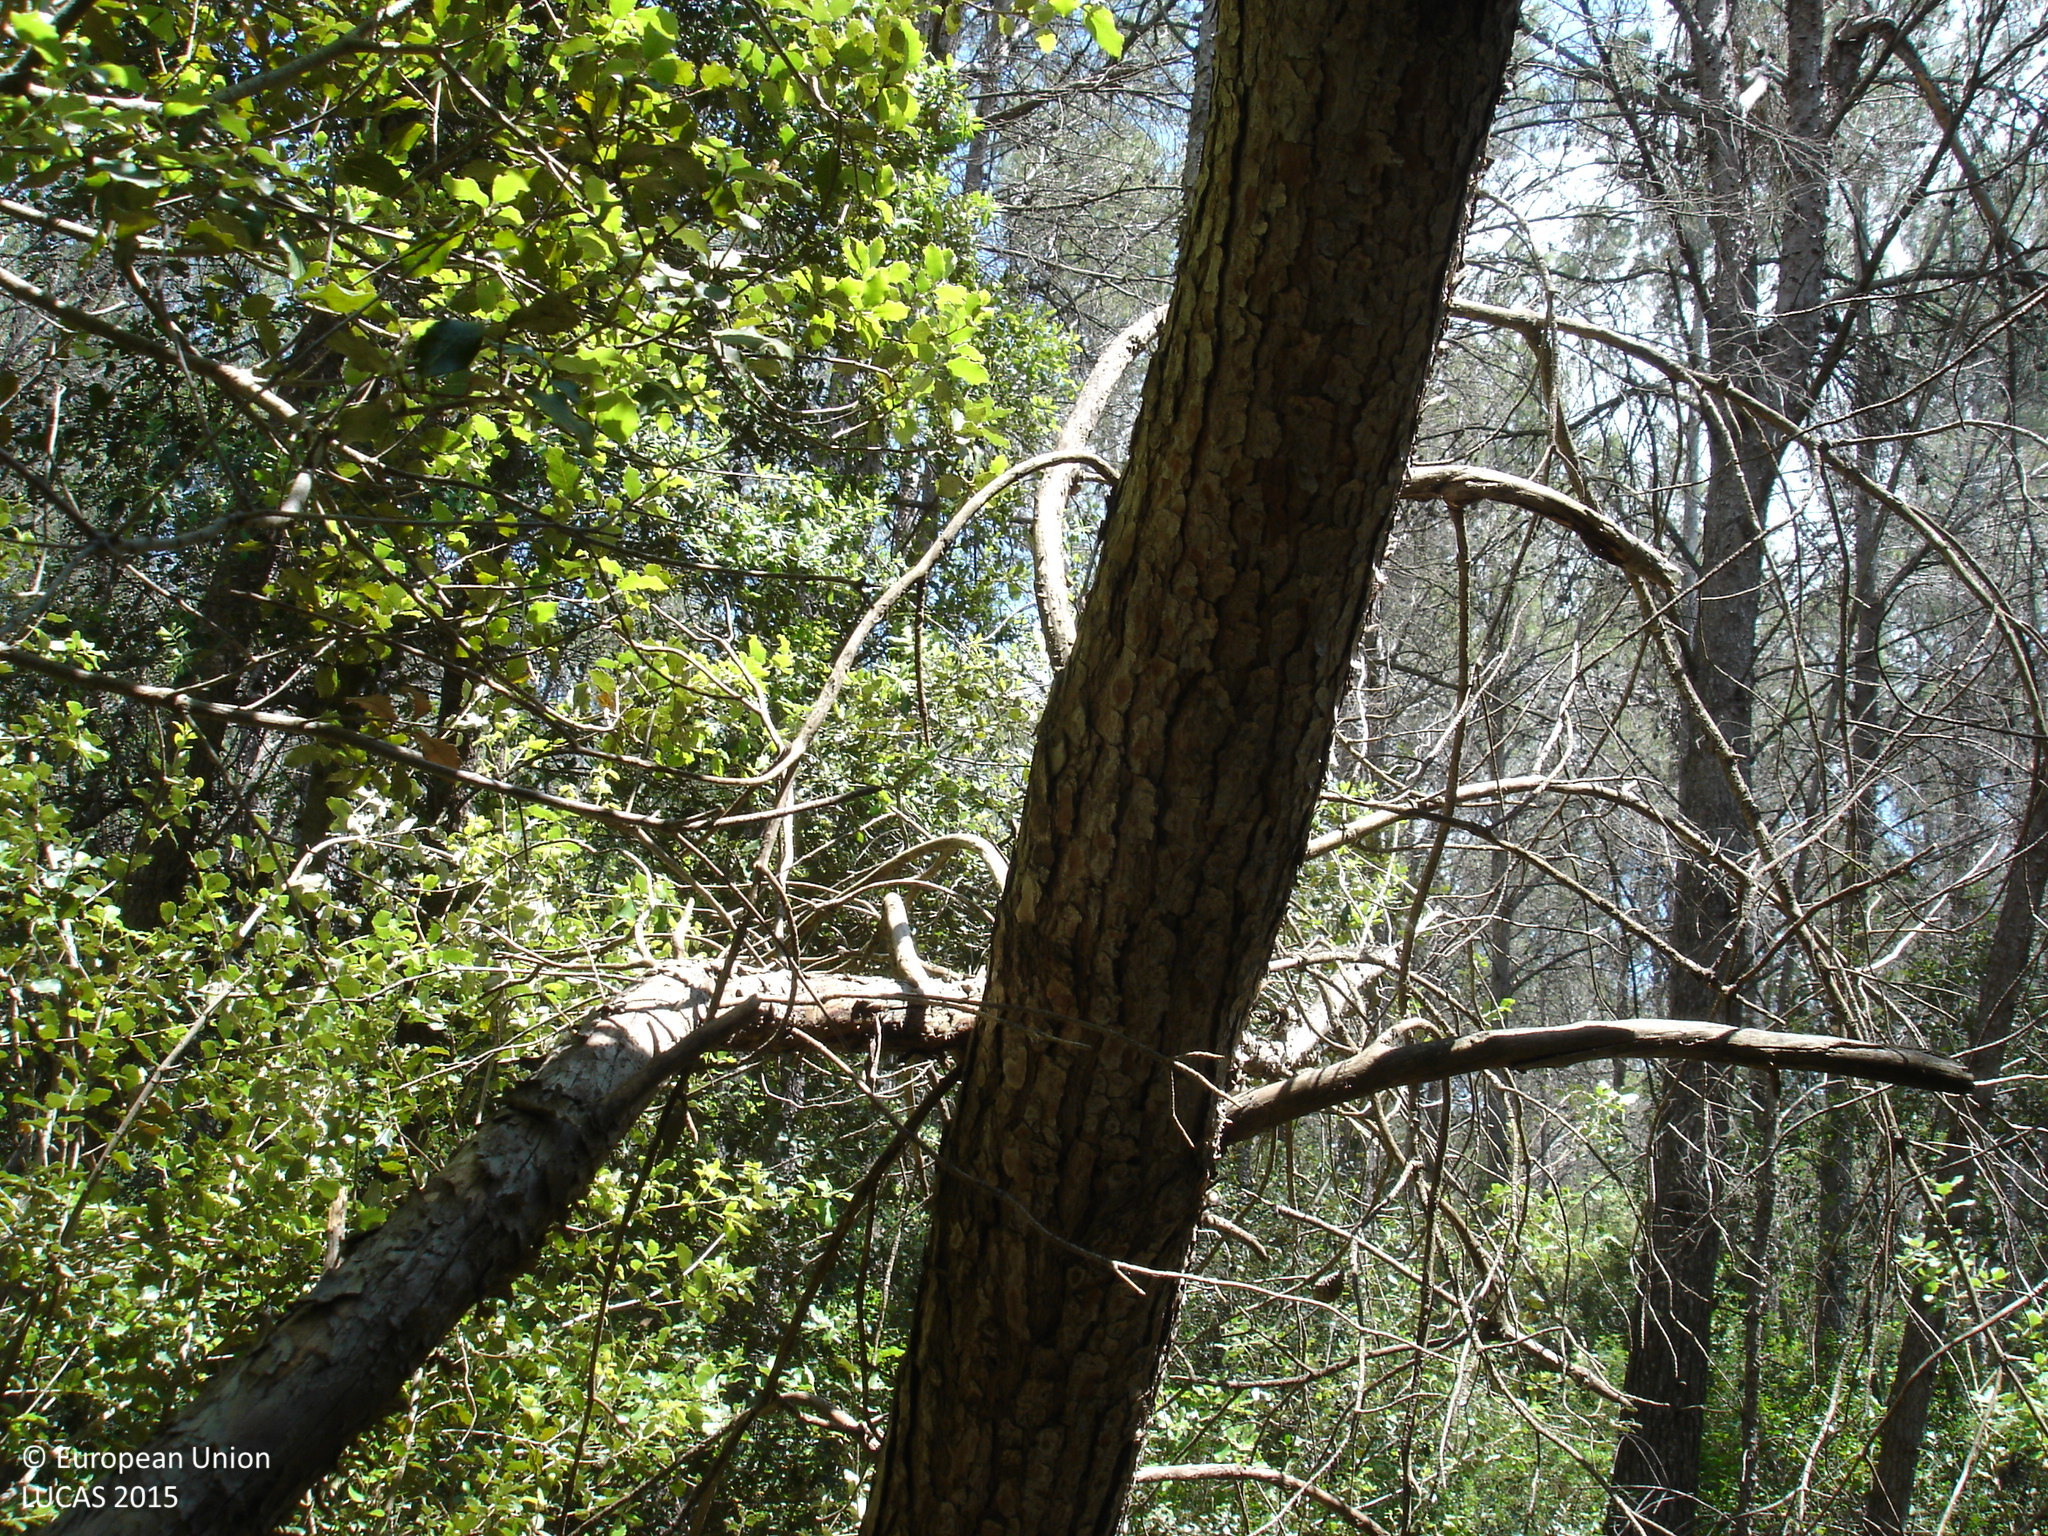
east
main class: Woodland
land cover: Pine dominated coniferous woodland
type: coniferous forest of the mediterranean region
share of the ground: > 75 %
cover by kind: coniferous forest trees 90 %, broadleaved forest trees 5 %, shrubs 5 %
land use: Forestry
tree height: > 5 m
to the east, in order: Pine dominated coniferous woodland; Tracks; Pine dominated coniferous woodland
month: May
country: ES
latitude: 42.1405
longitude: 3.0094
